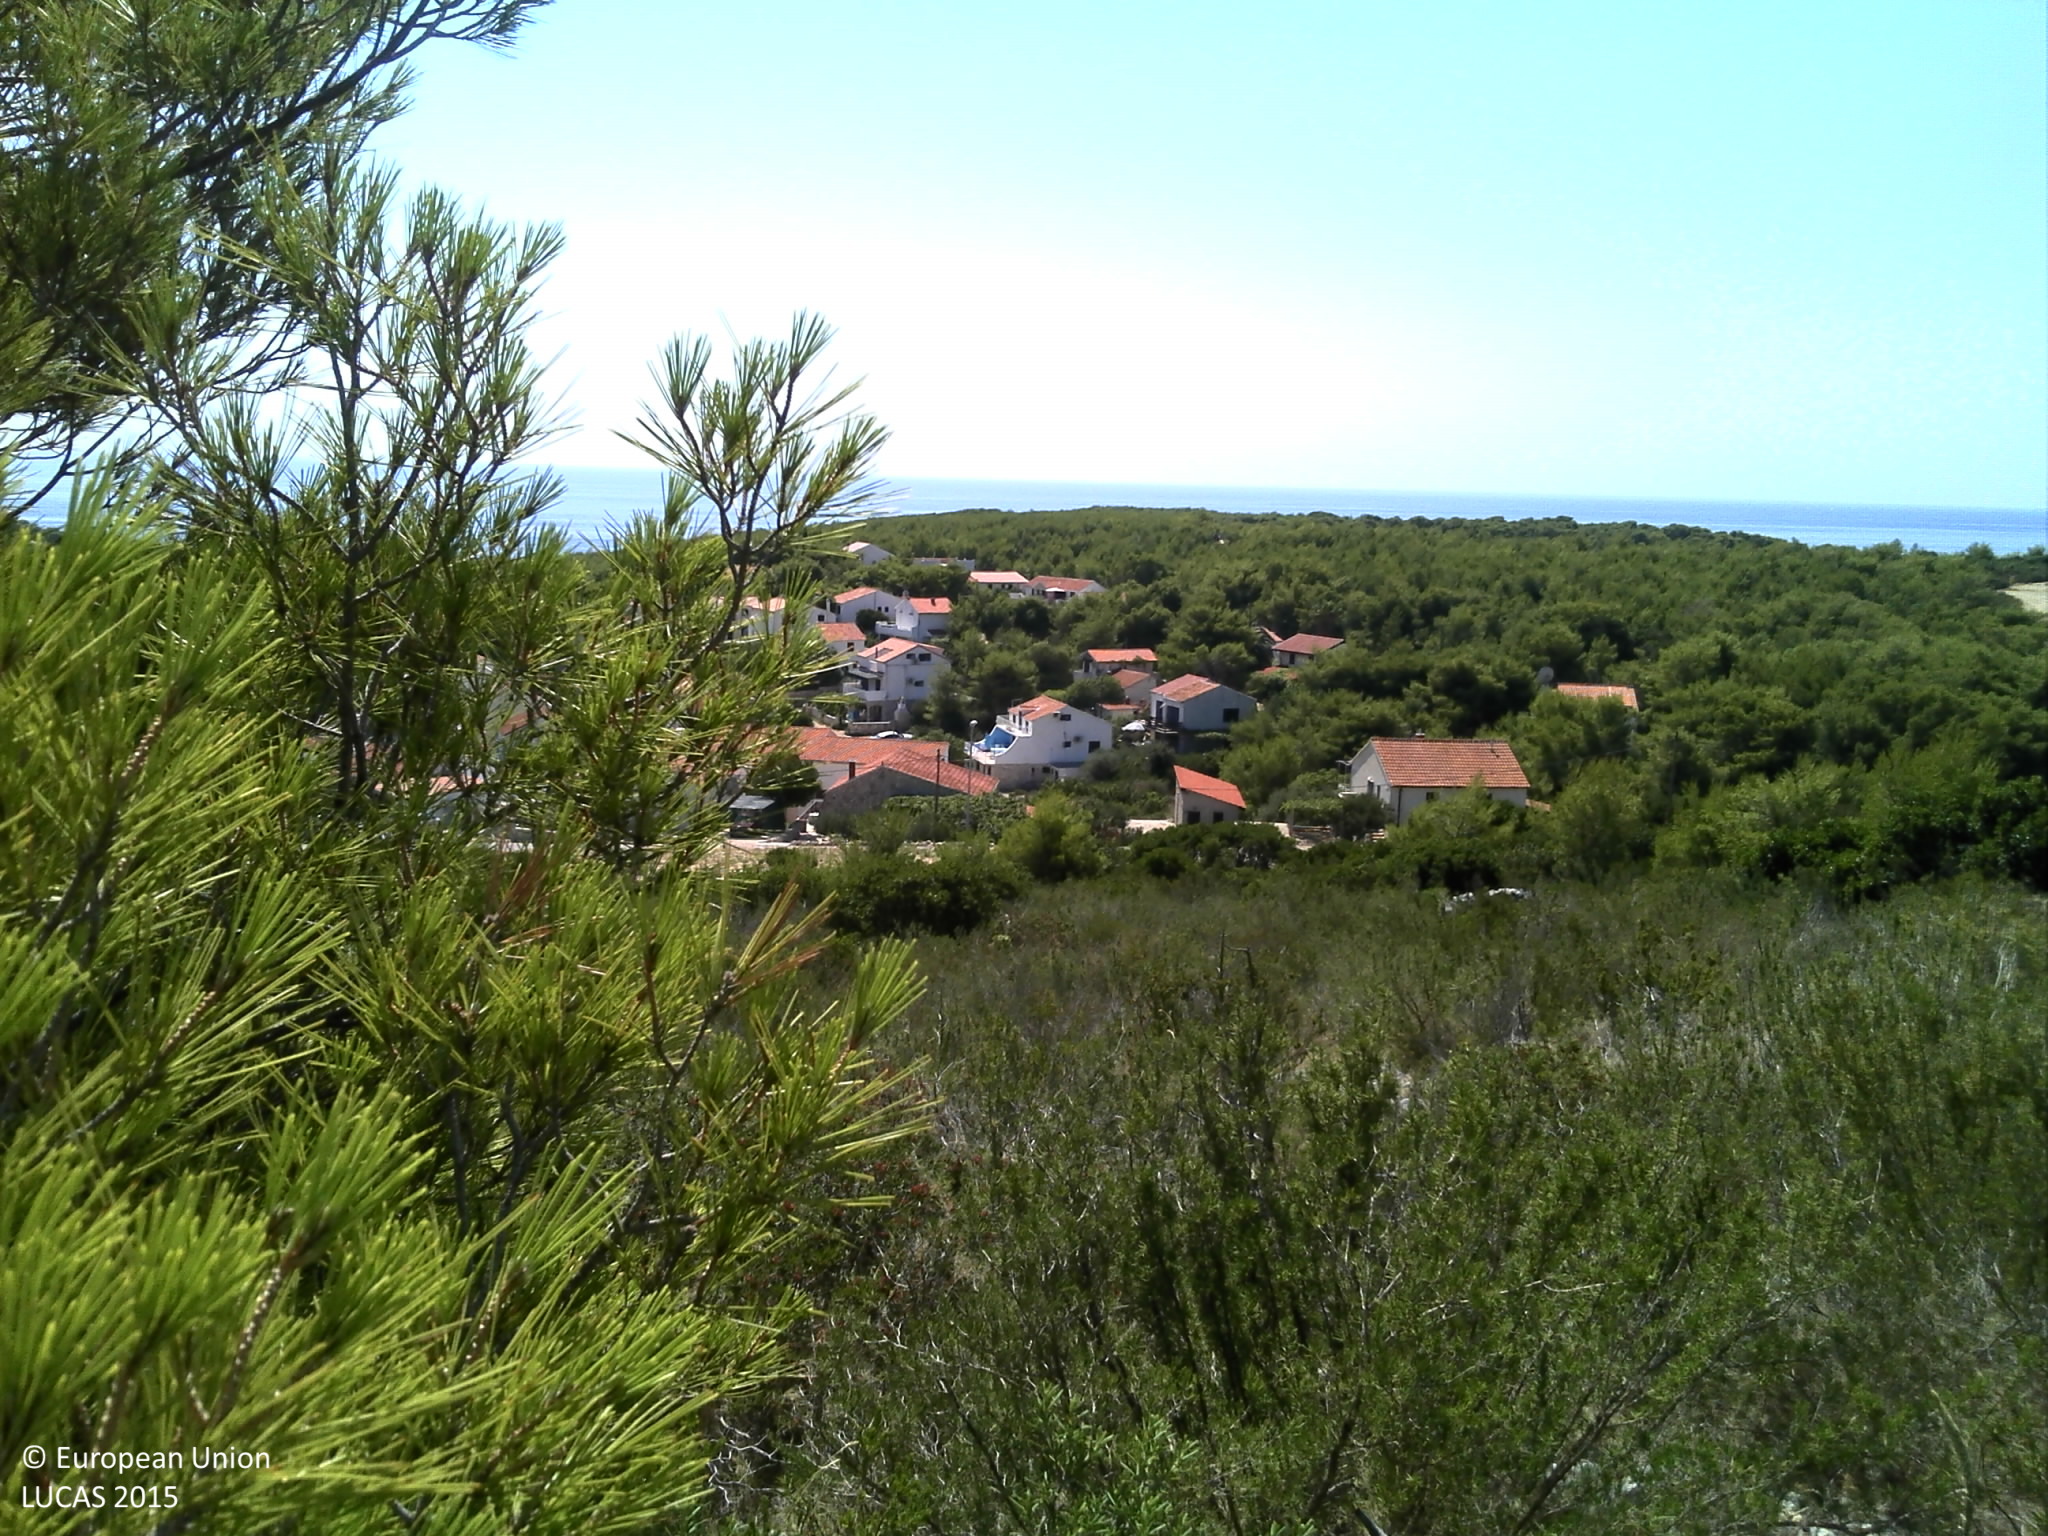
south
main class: Shrubland
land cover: Shrubland with sparse tree cover
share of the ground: > 75 %
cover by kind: shrubs 75 %, unconsolidated bare surface 10 %, coniferous forest trees 5 %, herbaceous plants 5 %, consolidated bare surface 5 %
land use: Semi-natural and natural areas not in use
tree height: > 5 m
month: August
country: HR
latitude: 43.0246
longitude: 16.2102
